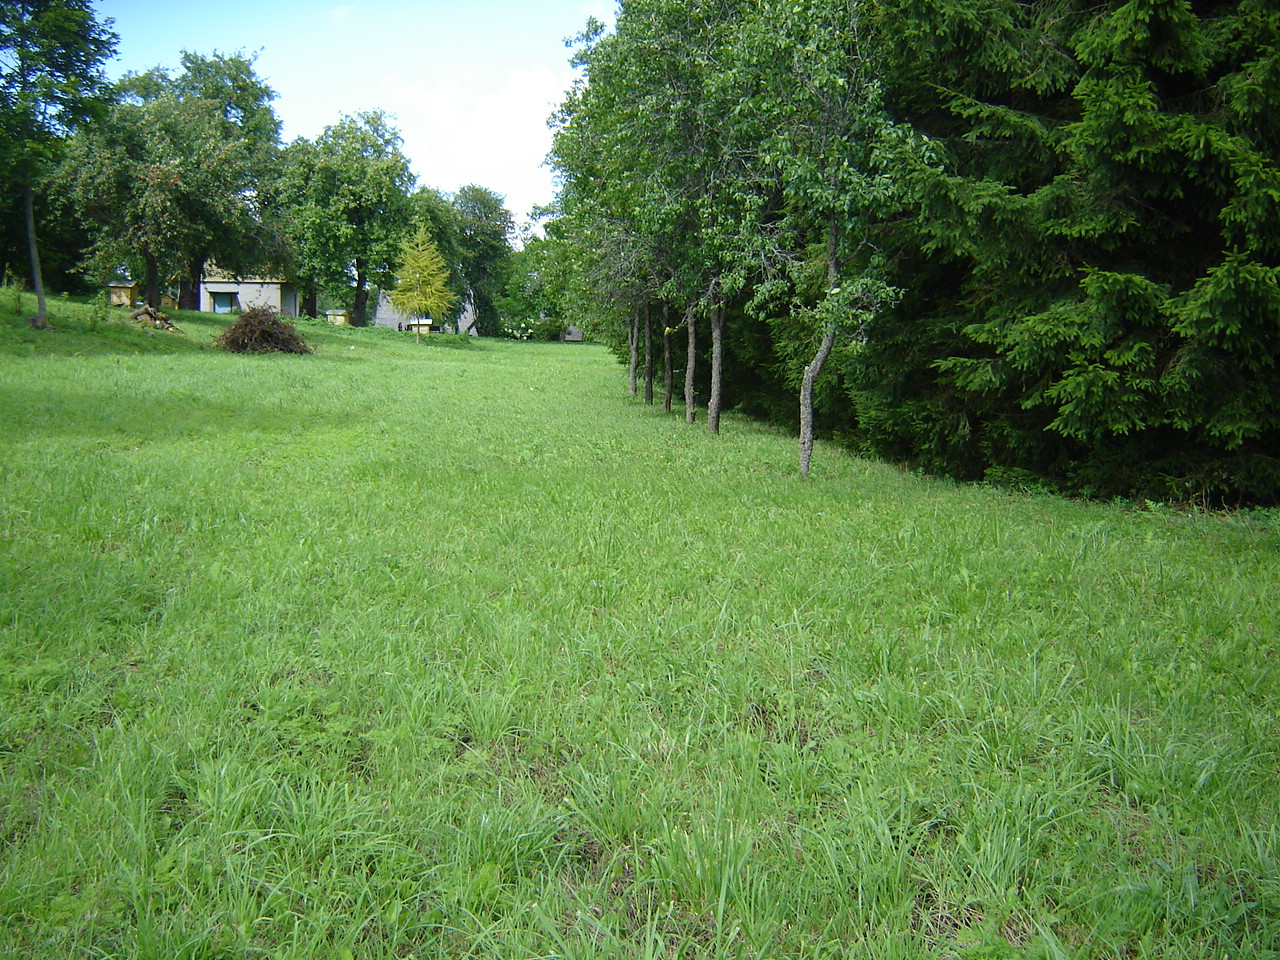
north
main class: Grassland
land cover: Grassland with sparse tree/shrub cover
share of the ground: > 75 %
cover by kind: herbaceous plants 95 %, broadleaved forest trees 5 %
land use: Agriculture (excluding fallow land and kitchen gardens)
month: July
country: LT
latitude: 55.2454
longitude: 25.1375
